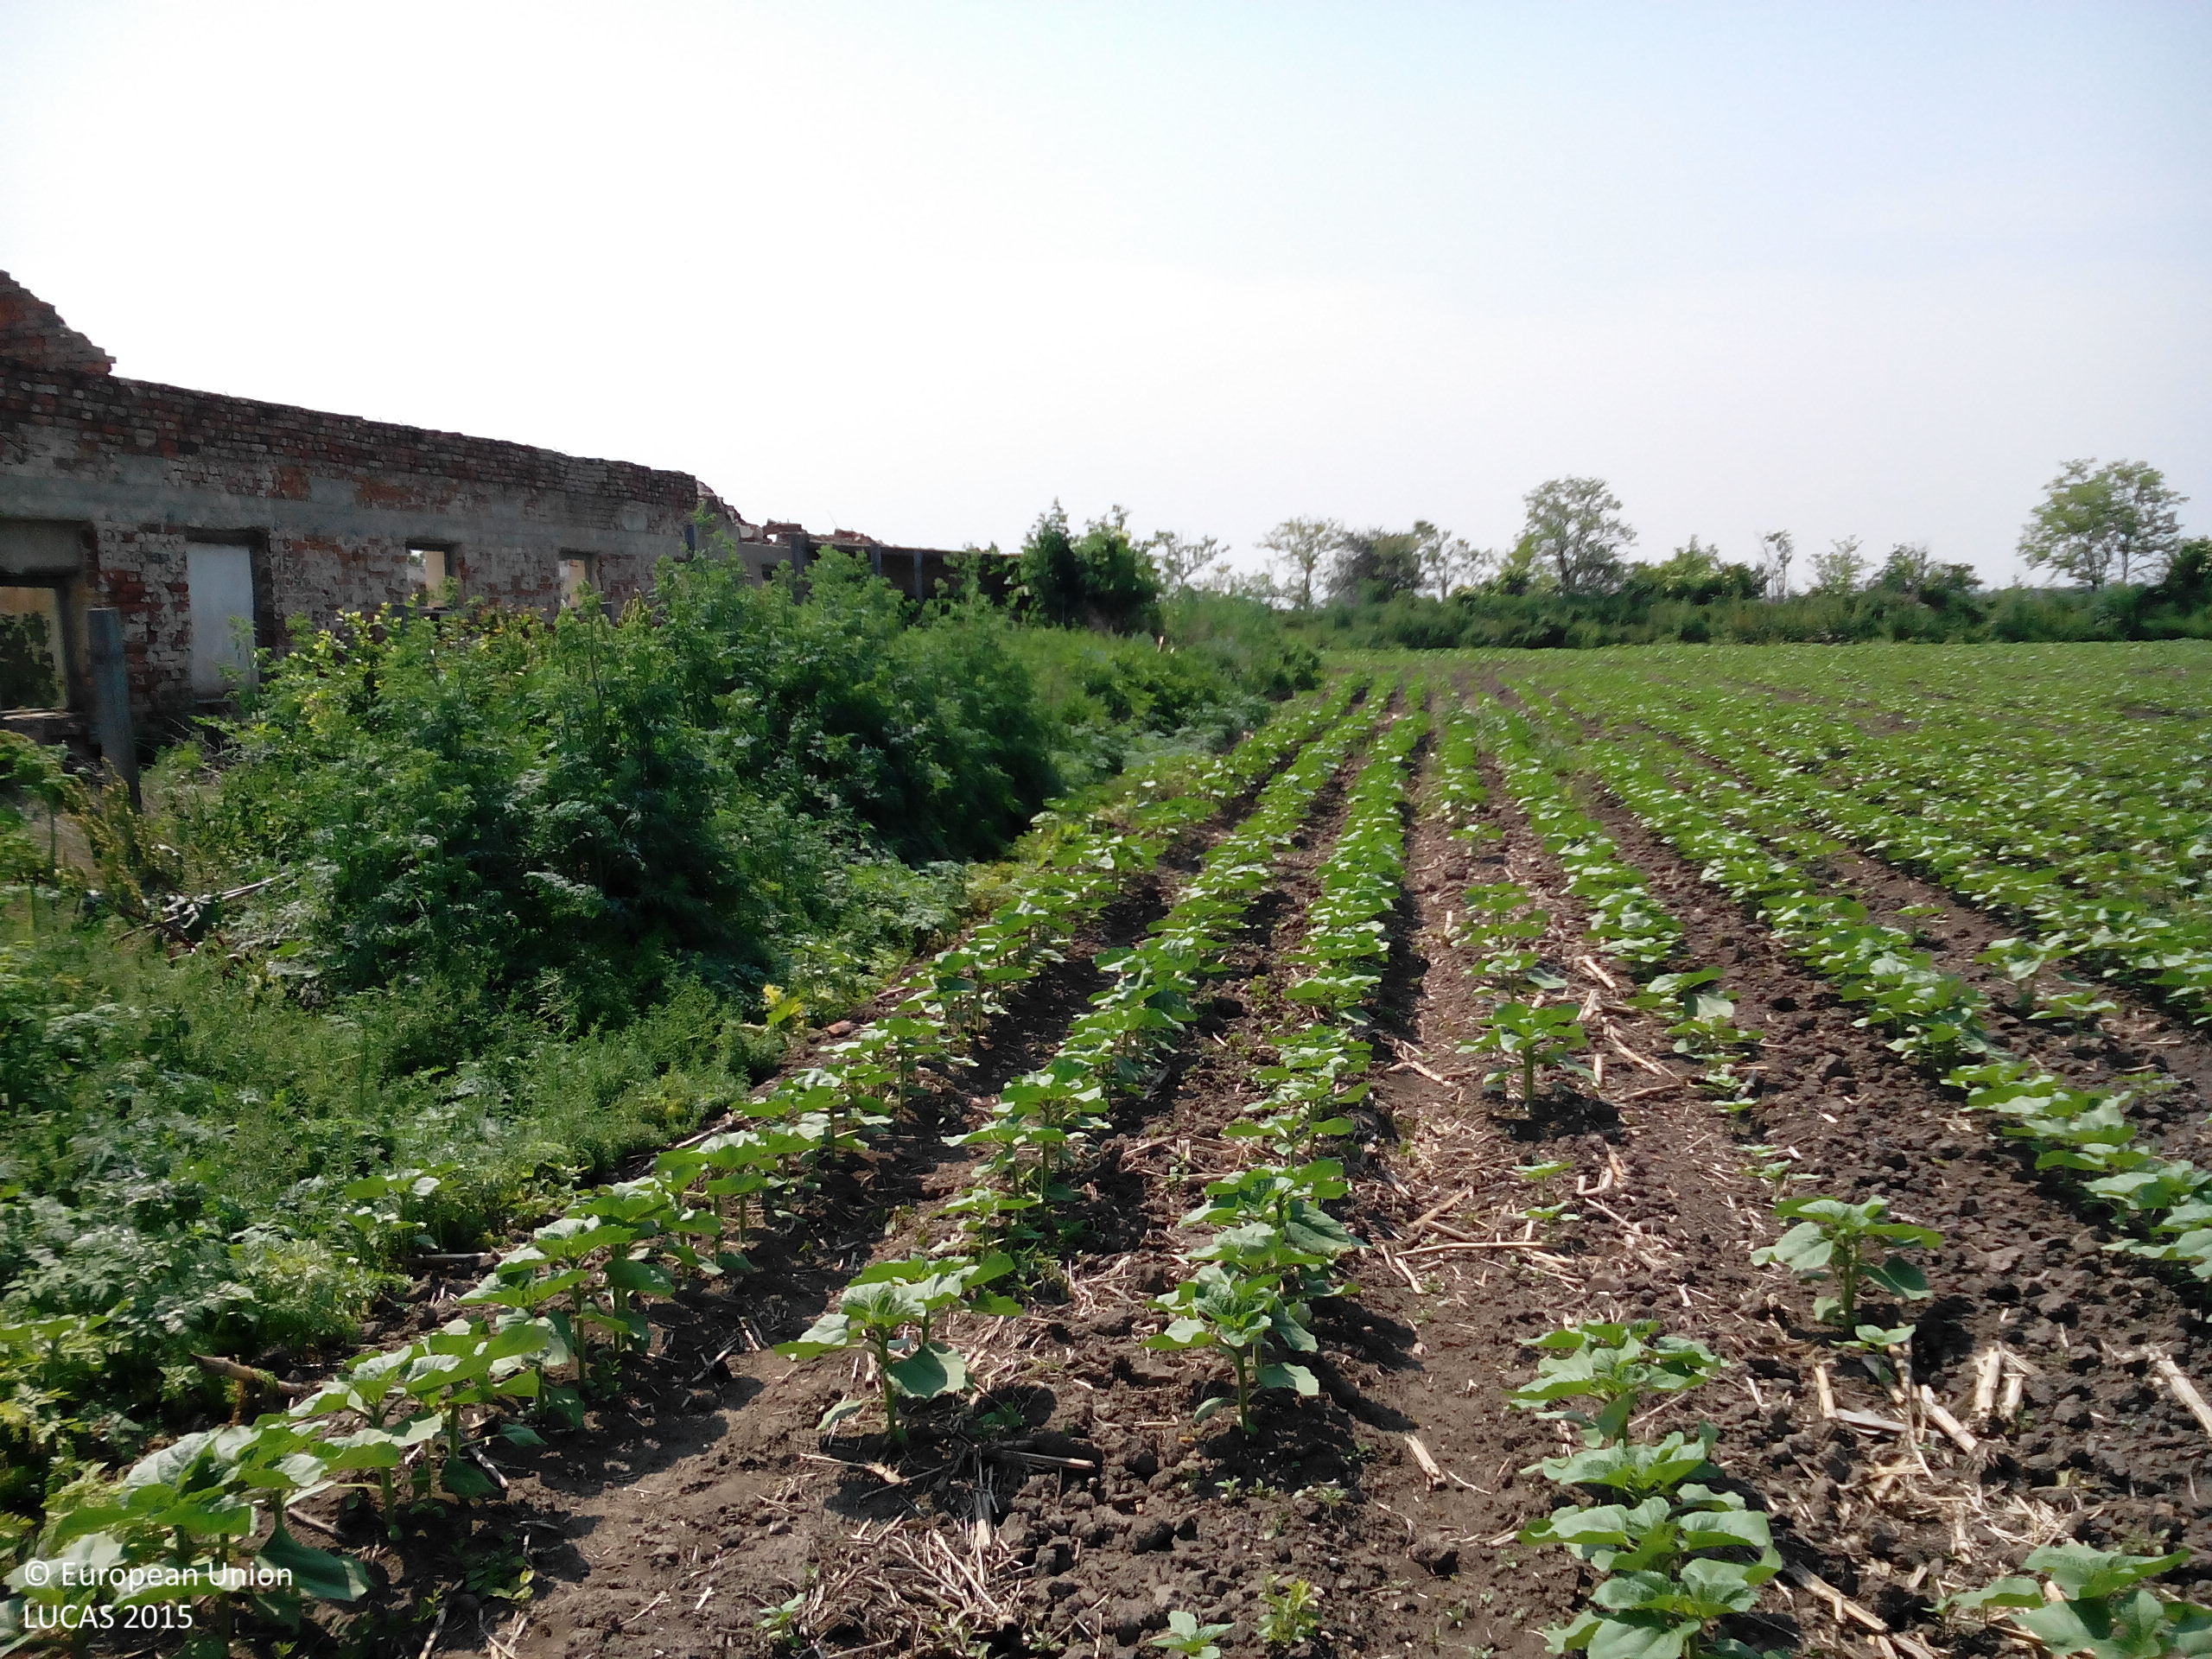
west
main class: Cropland
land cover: Sunflower
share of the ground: 25 - 50 %
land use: Agriculture (excluding fallow land and kitchen gardens)
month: May
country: BG
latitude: 43.6416
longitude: 24.0758
